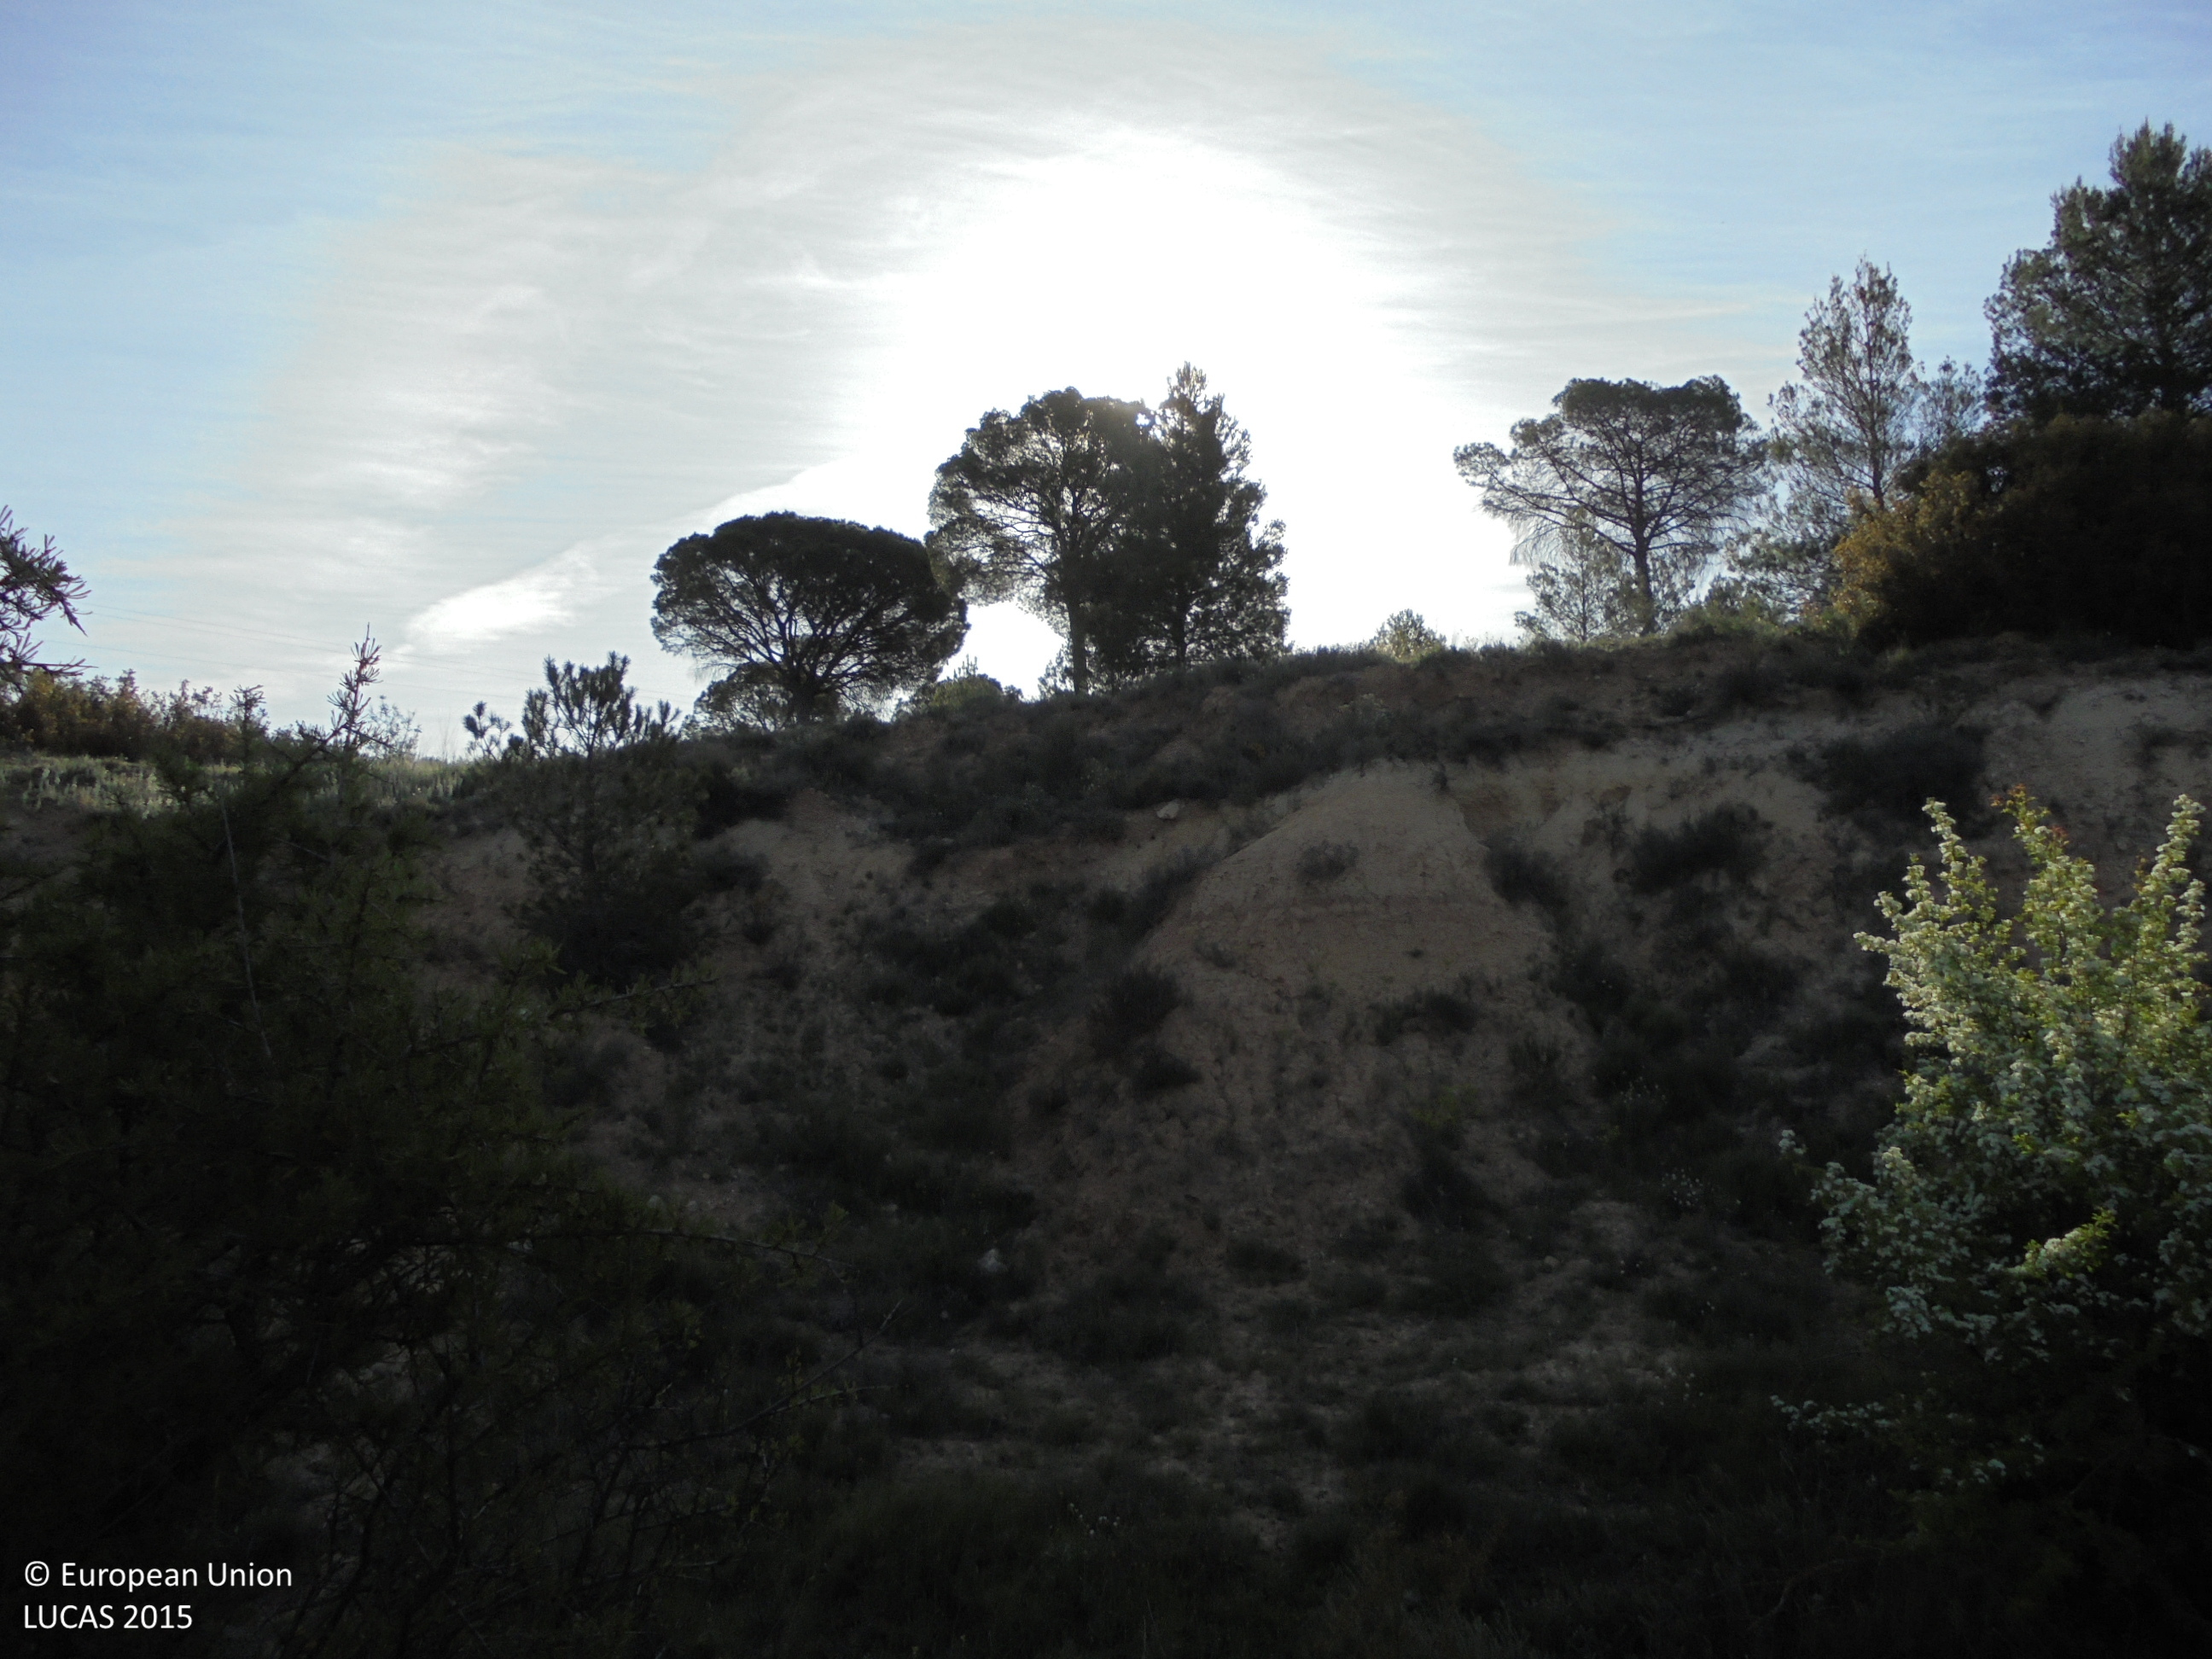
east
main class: Shrubland
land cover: Shrubland with sparse tree cover
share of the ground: 10 - 25 %
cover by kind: herbaceous plants 75 %, shrubs 15 %, coniferous forest trees 5 %, unconsolidated bare surface 5 %
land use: Semi-natural and natural areas not in use
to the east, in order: Shrubland with sparse tree cover; Pine dominated coniferous woodland; Barley; Electric lines; Barley; Pine dominated coniferous woodland
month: May
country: ES
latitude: 39.1598
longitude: -1.7247
